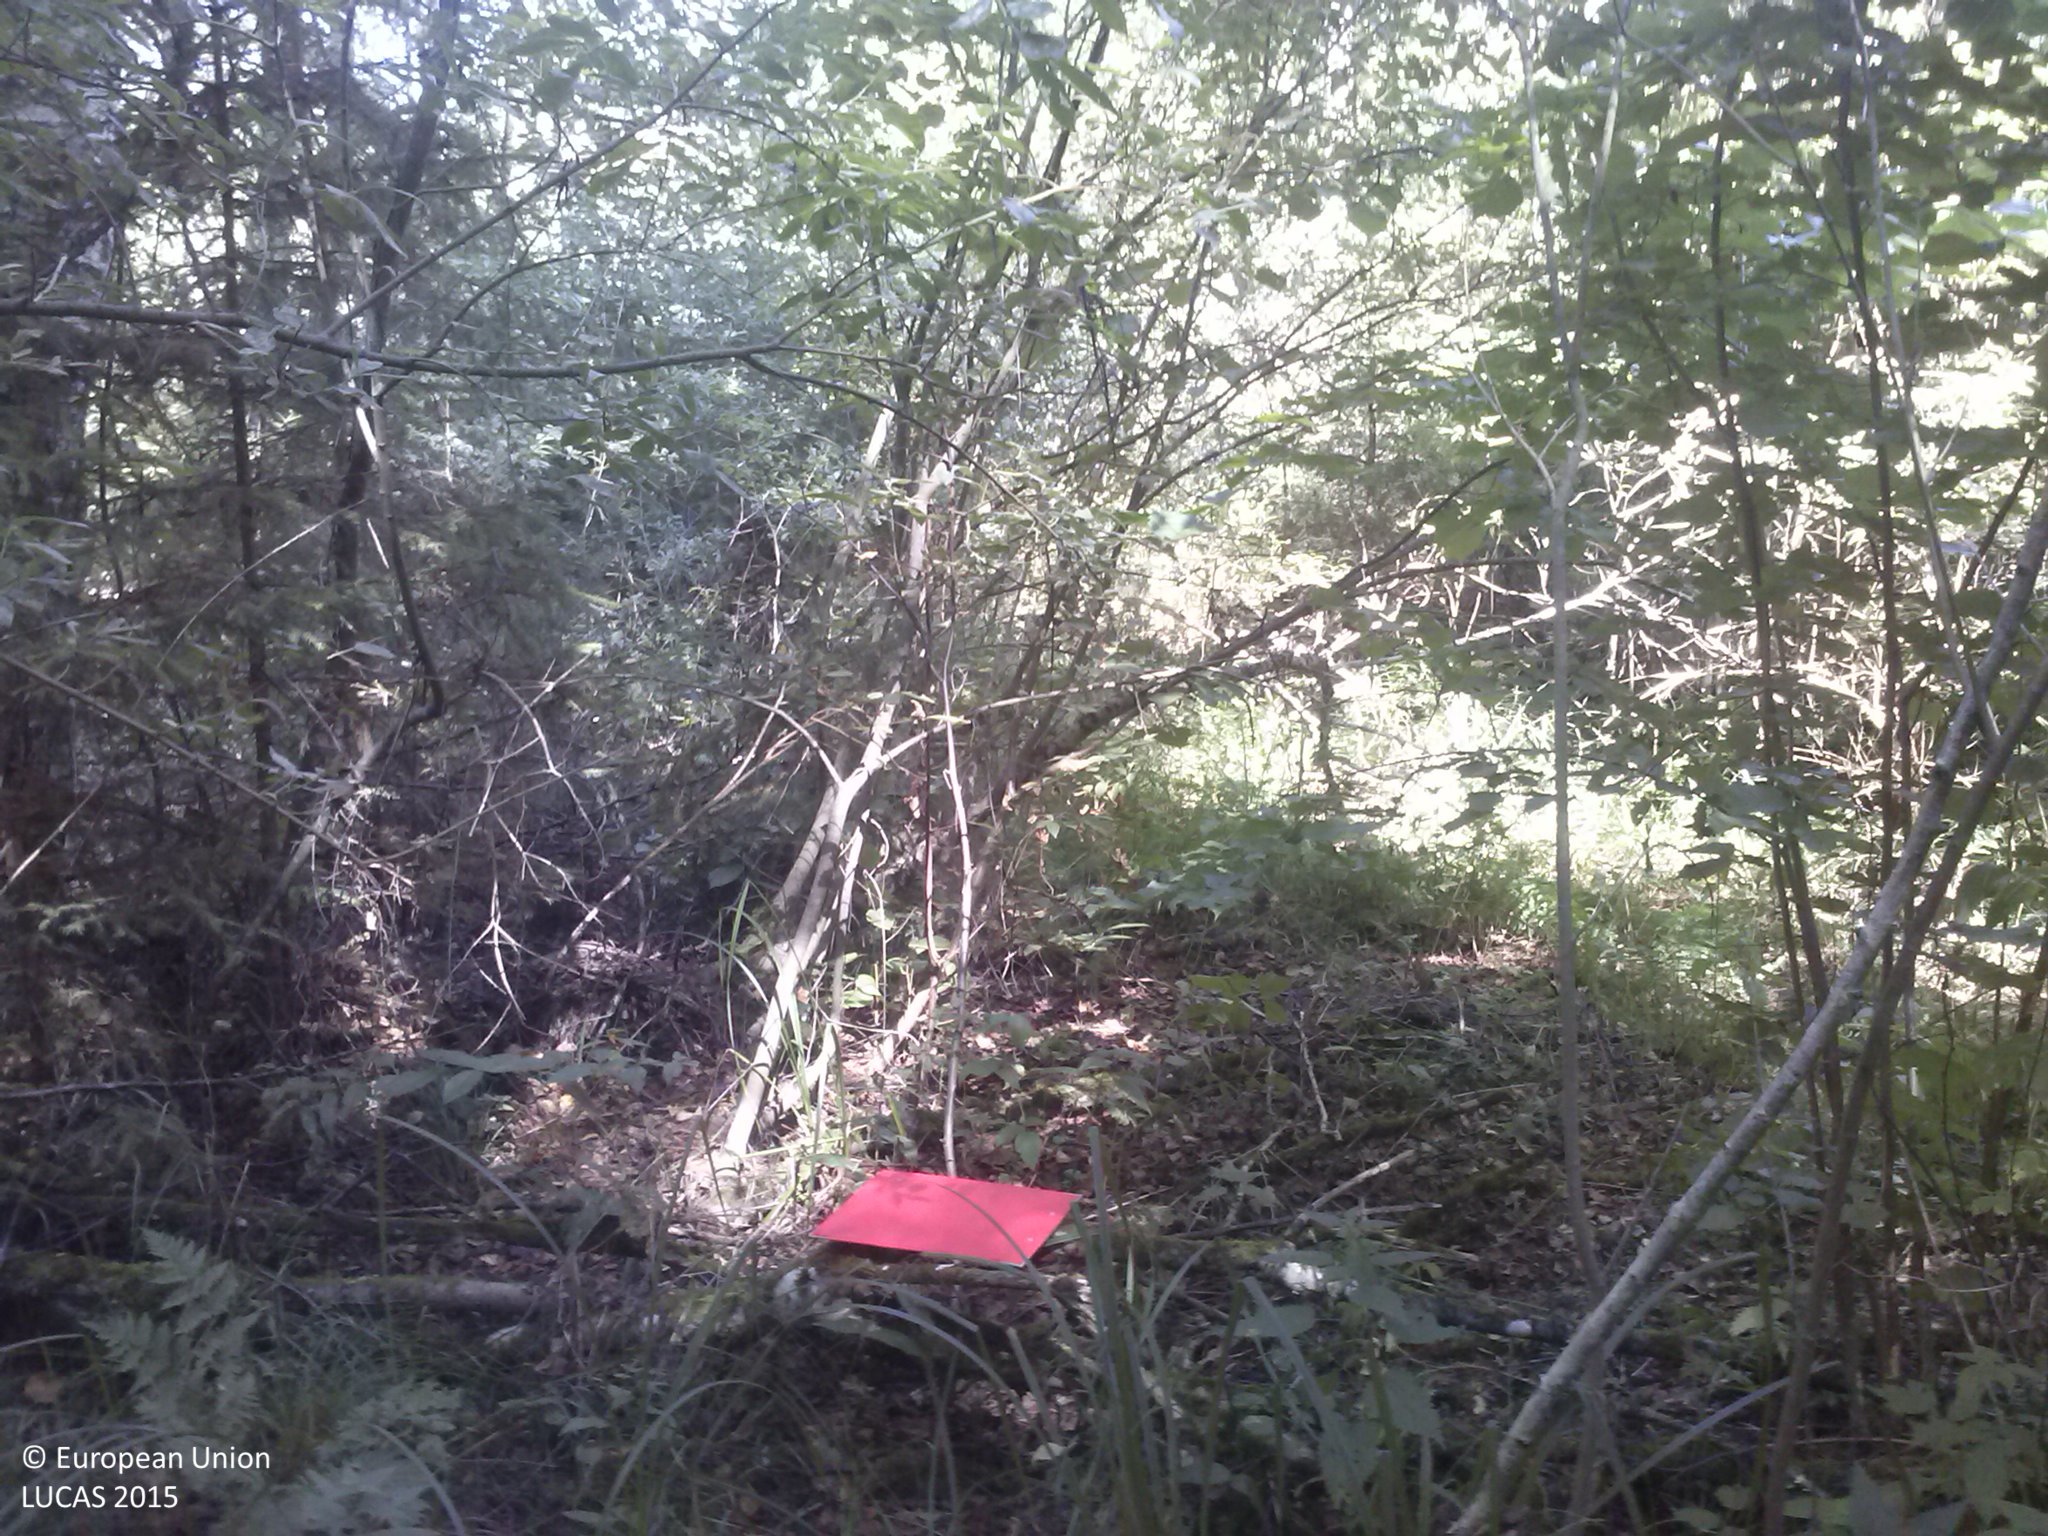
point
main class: Woodland
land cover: Broadleaved woodland
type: non-riverine alder, birch or aspen forest
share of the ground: > 75 %
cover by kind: broadleaved forest trees 75 %, herbaceous plants 25 %
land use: Forestry
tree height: > 5 m
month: August
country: LV
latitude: 56.2430
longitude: 26.8277
